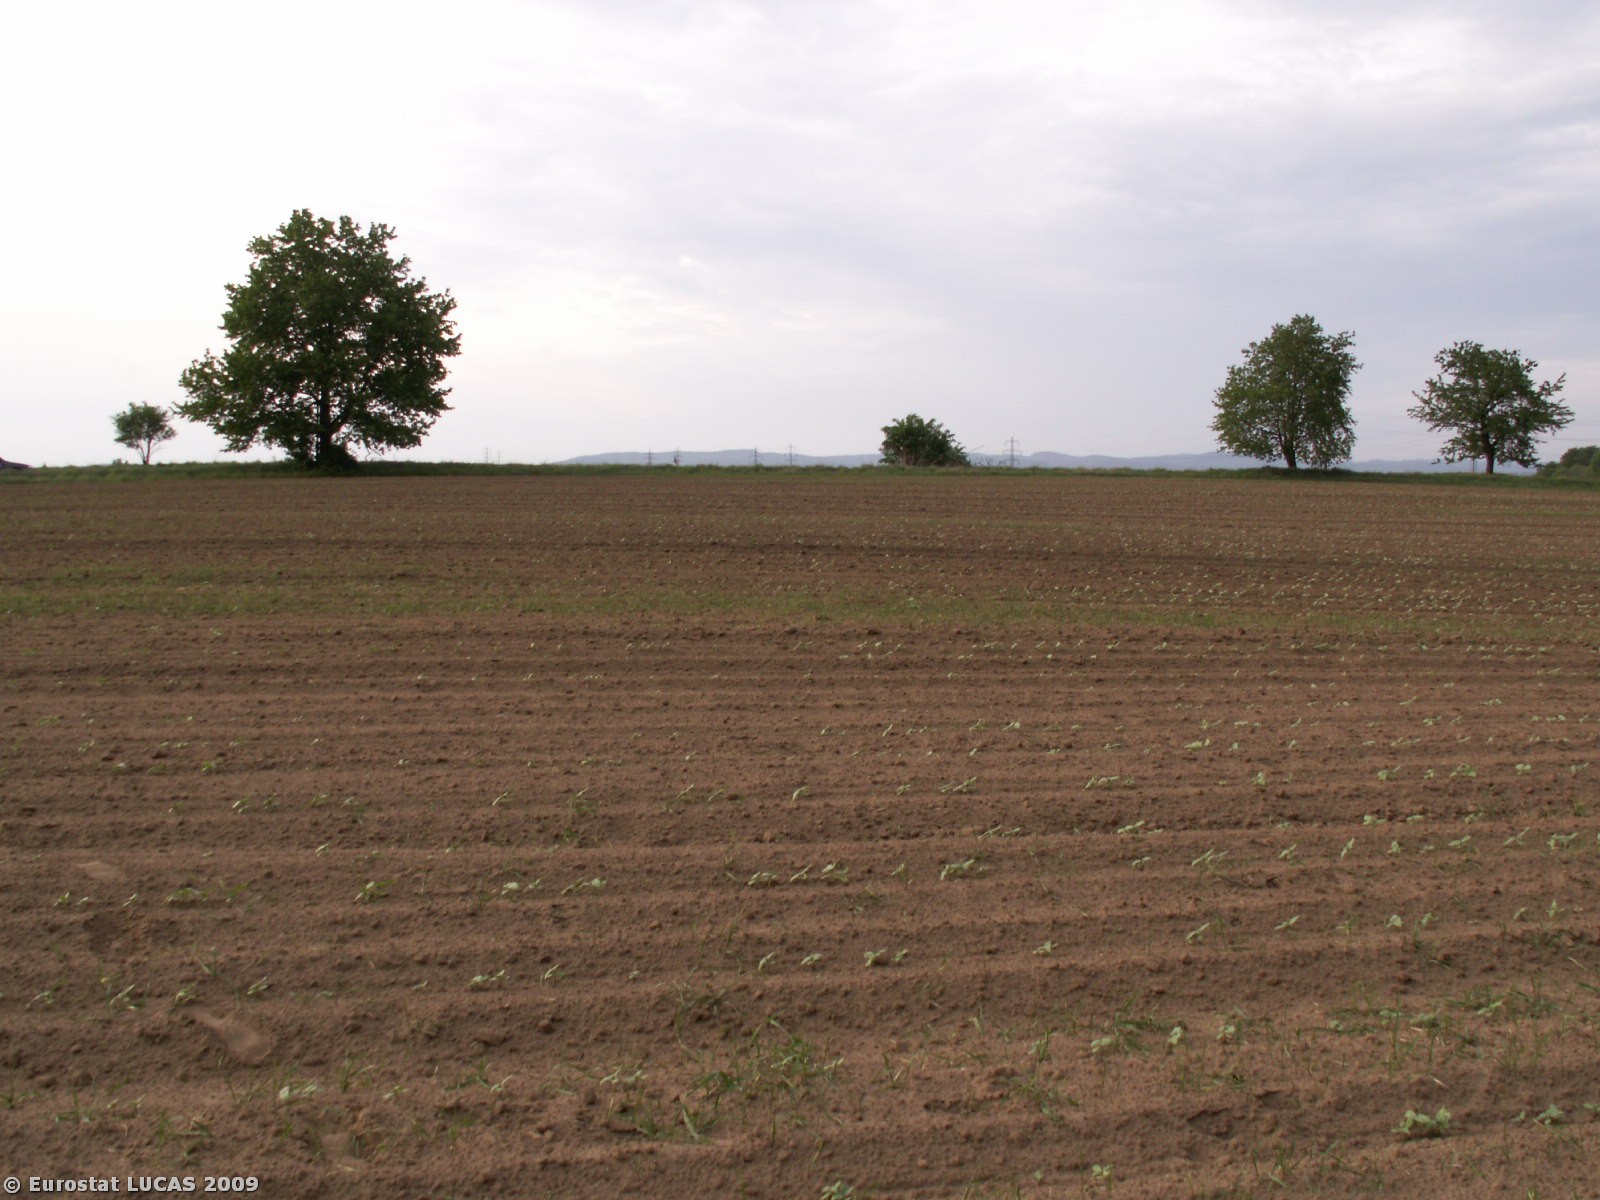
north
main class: Cropland
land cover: Sunflower
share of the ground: < 10 %
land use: Agriculture (excluding fallow land and kitchen gardens)
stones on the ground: < 10 %
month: May
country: CZ
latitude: 48.9663
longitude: 17.1536
